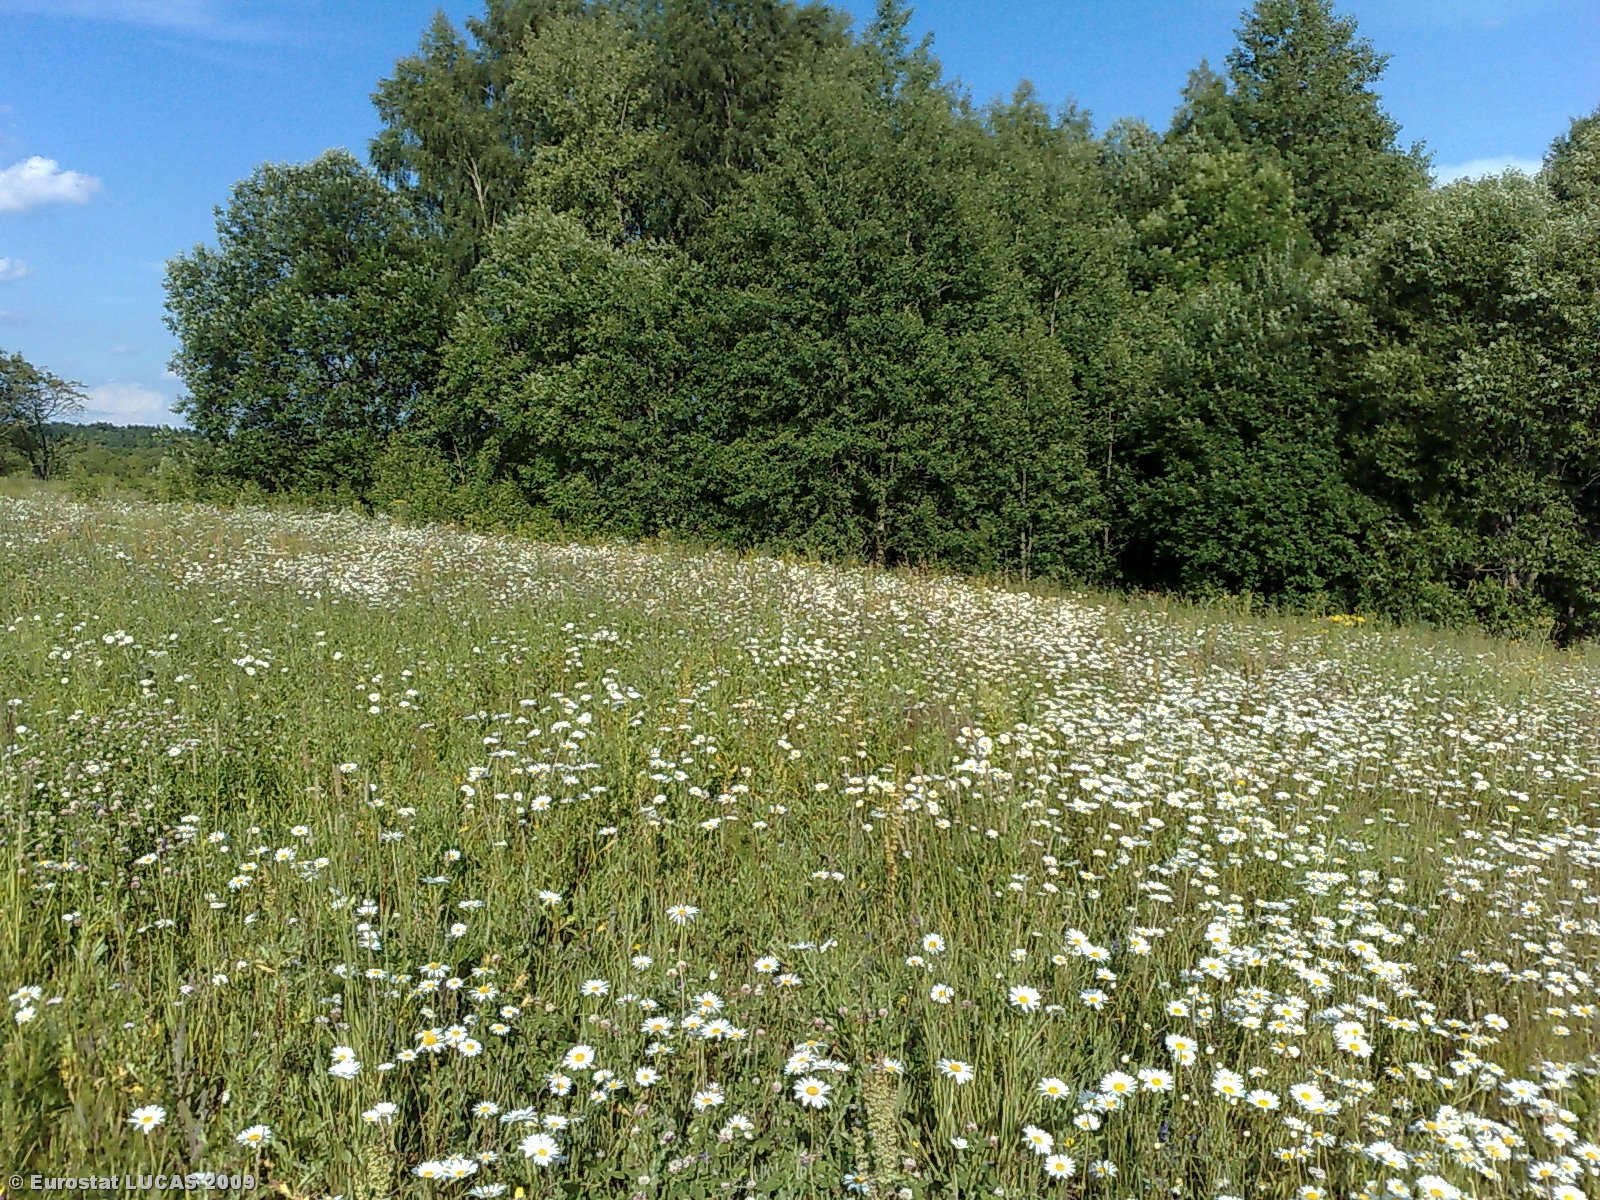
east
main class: Grassland
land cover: Grassland without tree/shrub cover
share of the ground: > 75 %
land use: Agriculture (excluding fallow land and kitchen gardens)
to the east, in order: Grassland without tree/shrub cover; Broadleaved woodland; Ditches and canals; Mixed woodland; Grassland without tree/shrub cover; Shrubland with sparse tree cover
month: July
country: LT
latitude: 55.5328
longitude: 22.7239
